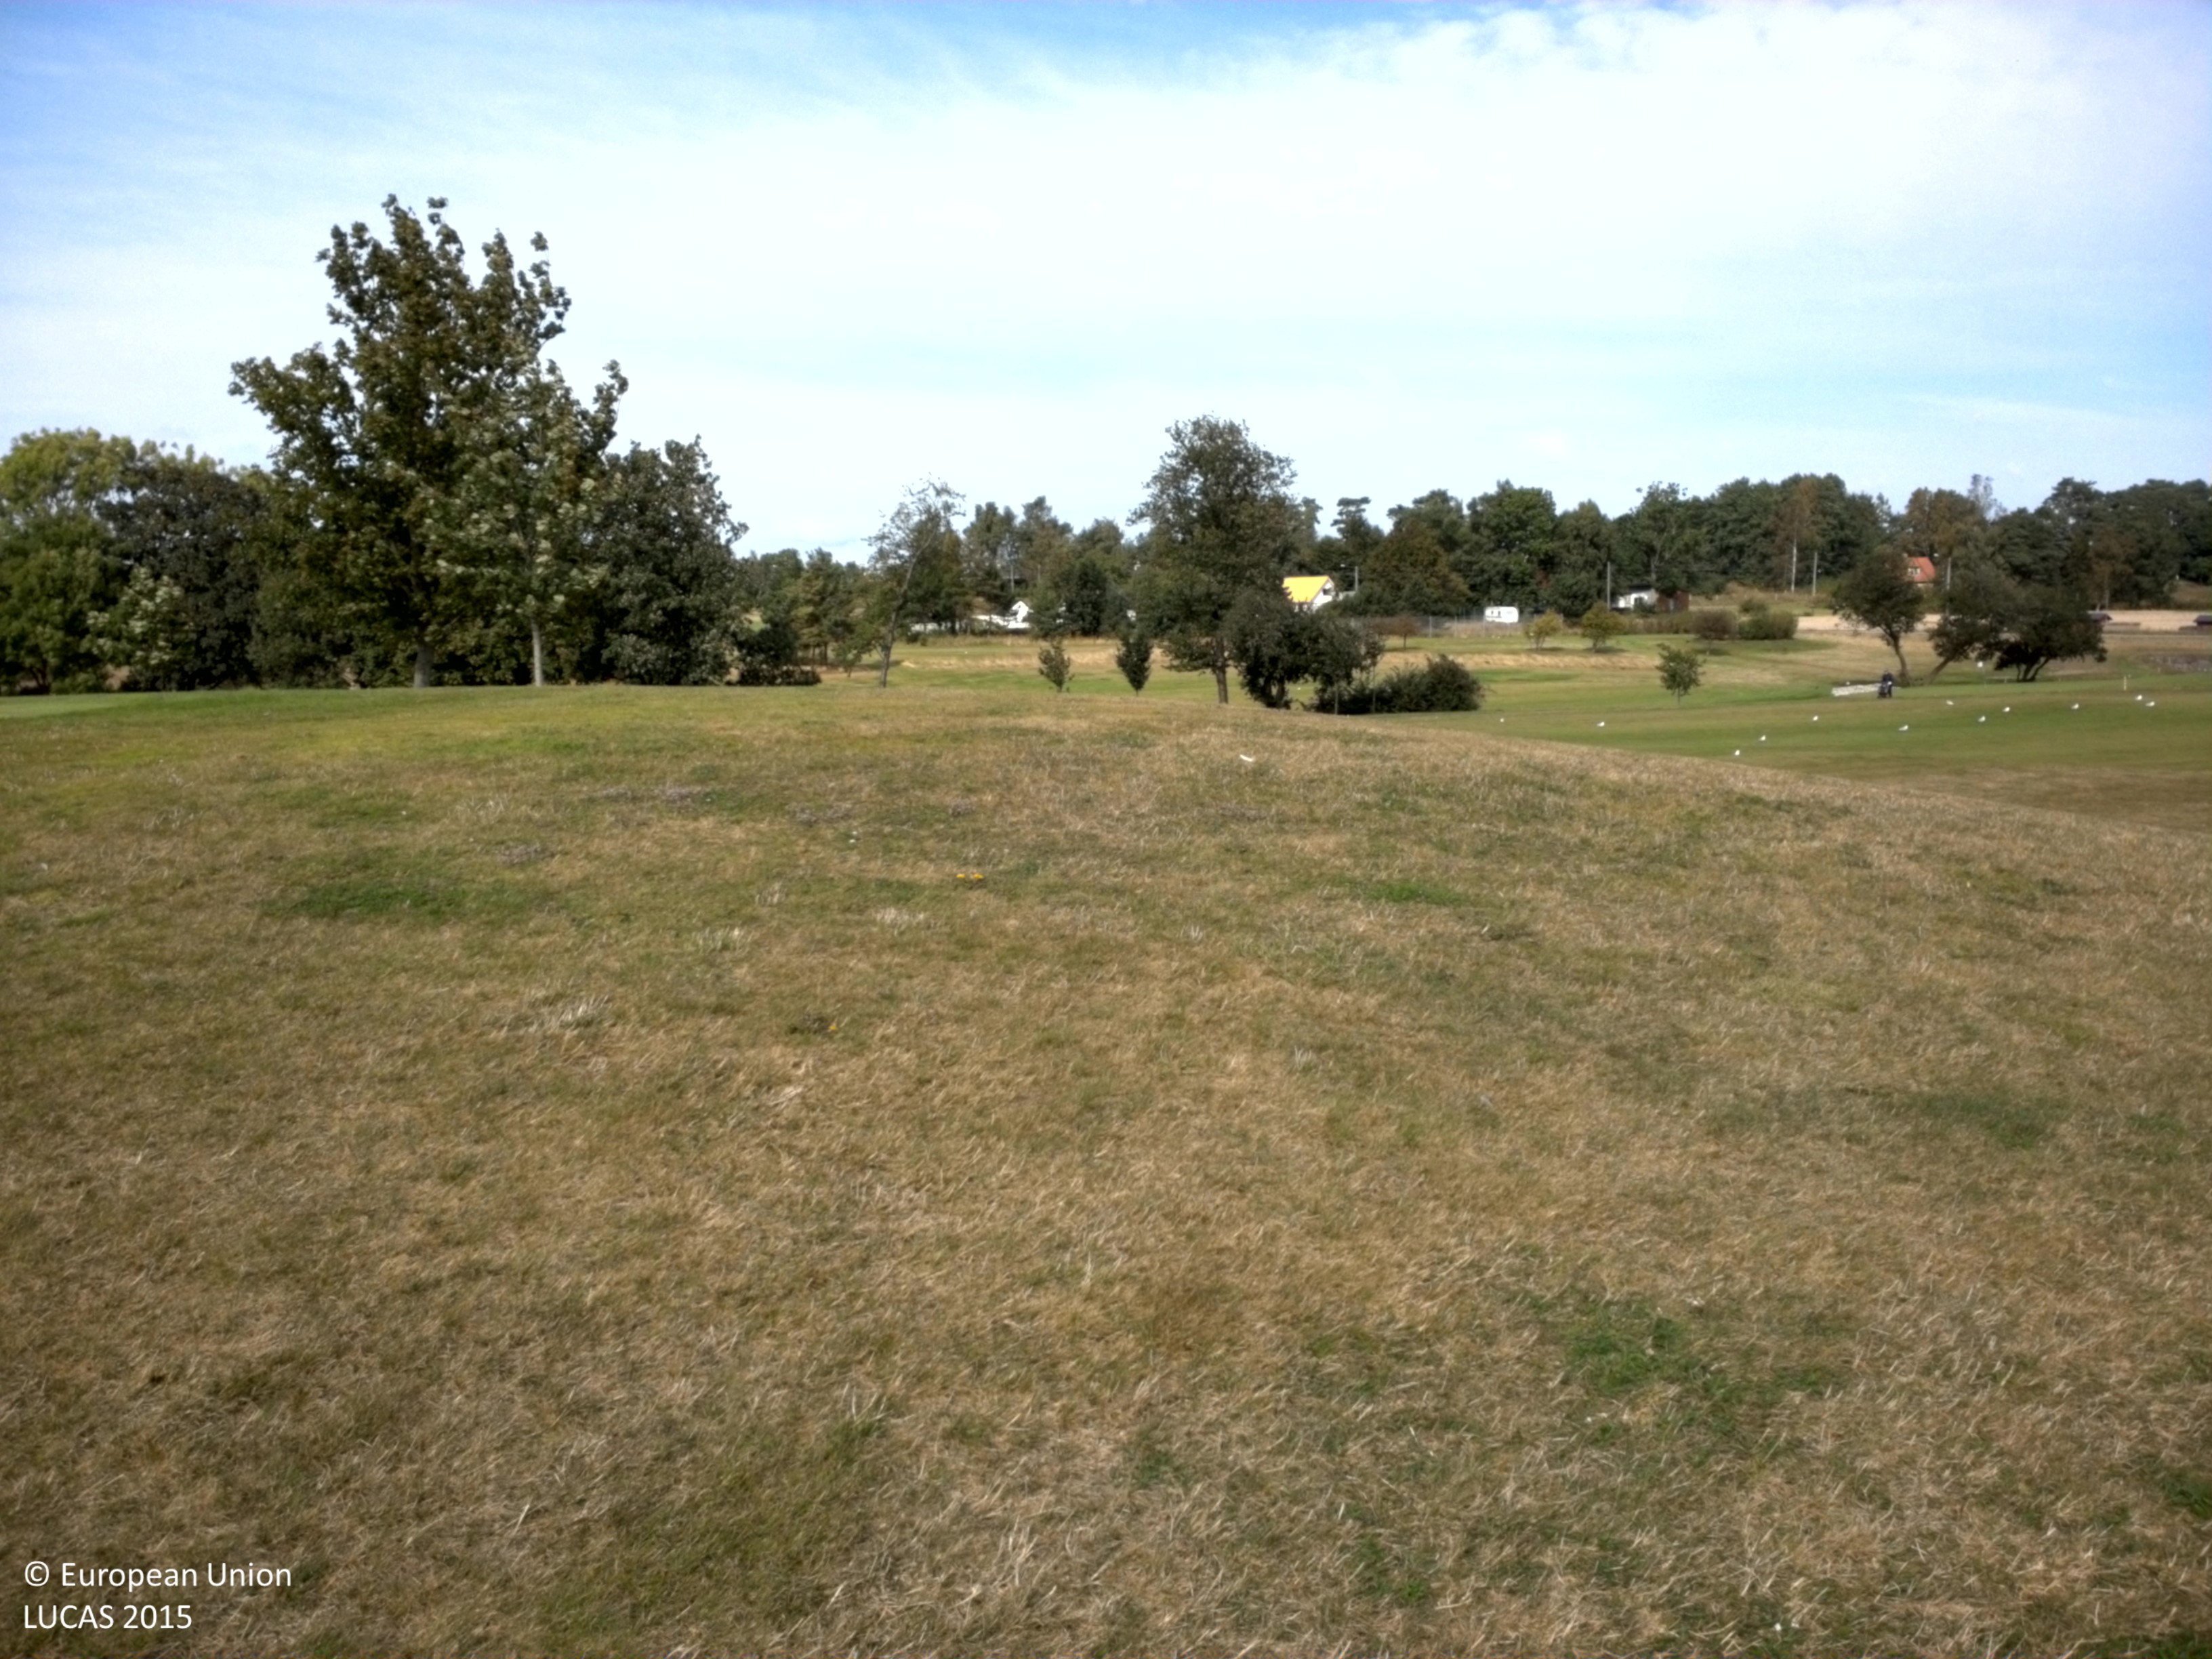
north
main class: Grassland
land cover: Grassland without tree/shrub cover
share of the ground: > 75 %
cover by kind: herbaceous plants 100 %
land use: Sport
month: September
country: SE
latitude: 55.5323
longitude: 13.9752
